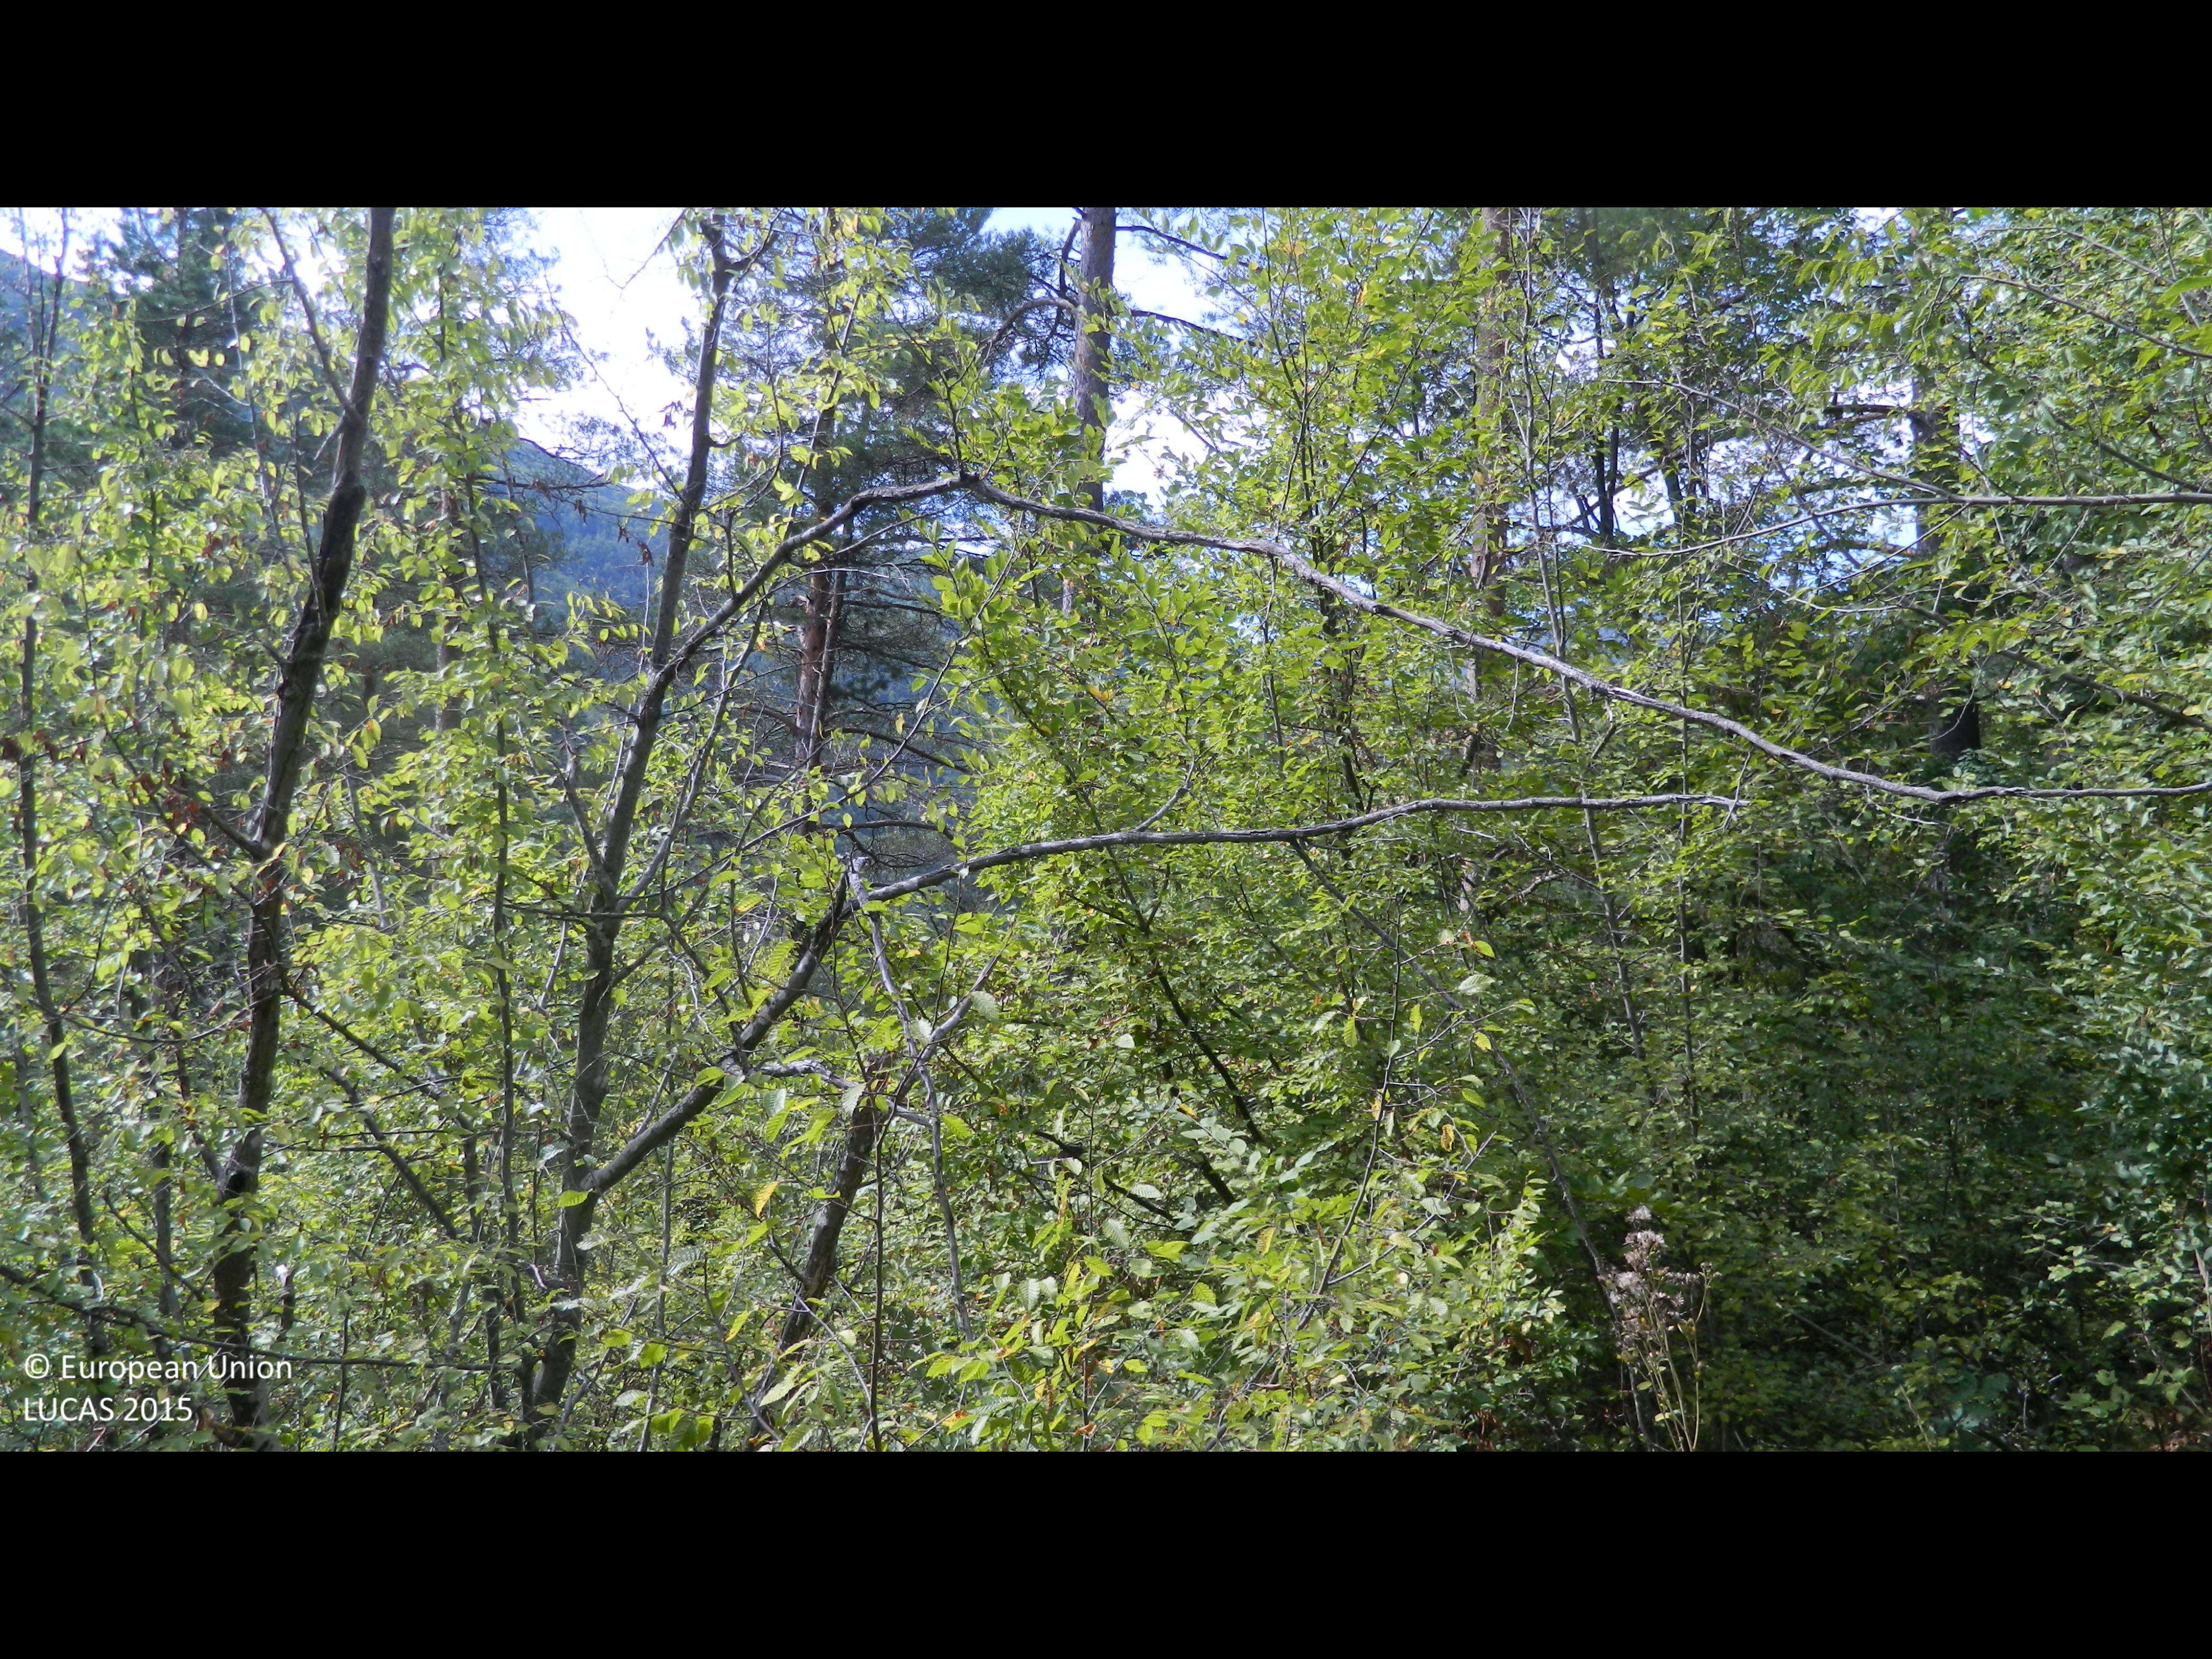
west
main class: Woodland
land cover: Other mixed woodland
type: hemiboreal forest and nemoral coniferous forest and mixed broadleaved-coniferous forest
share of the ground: > 75 %
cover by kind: broadleaved forest trees 75 %, coniferous forest trees 25 %
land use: Semi-natural and natural areas not in use
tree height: > 5 m
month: October
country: BG
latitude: 41.5449
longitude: 24.8997
